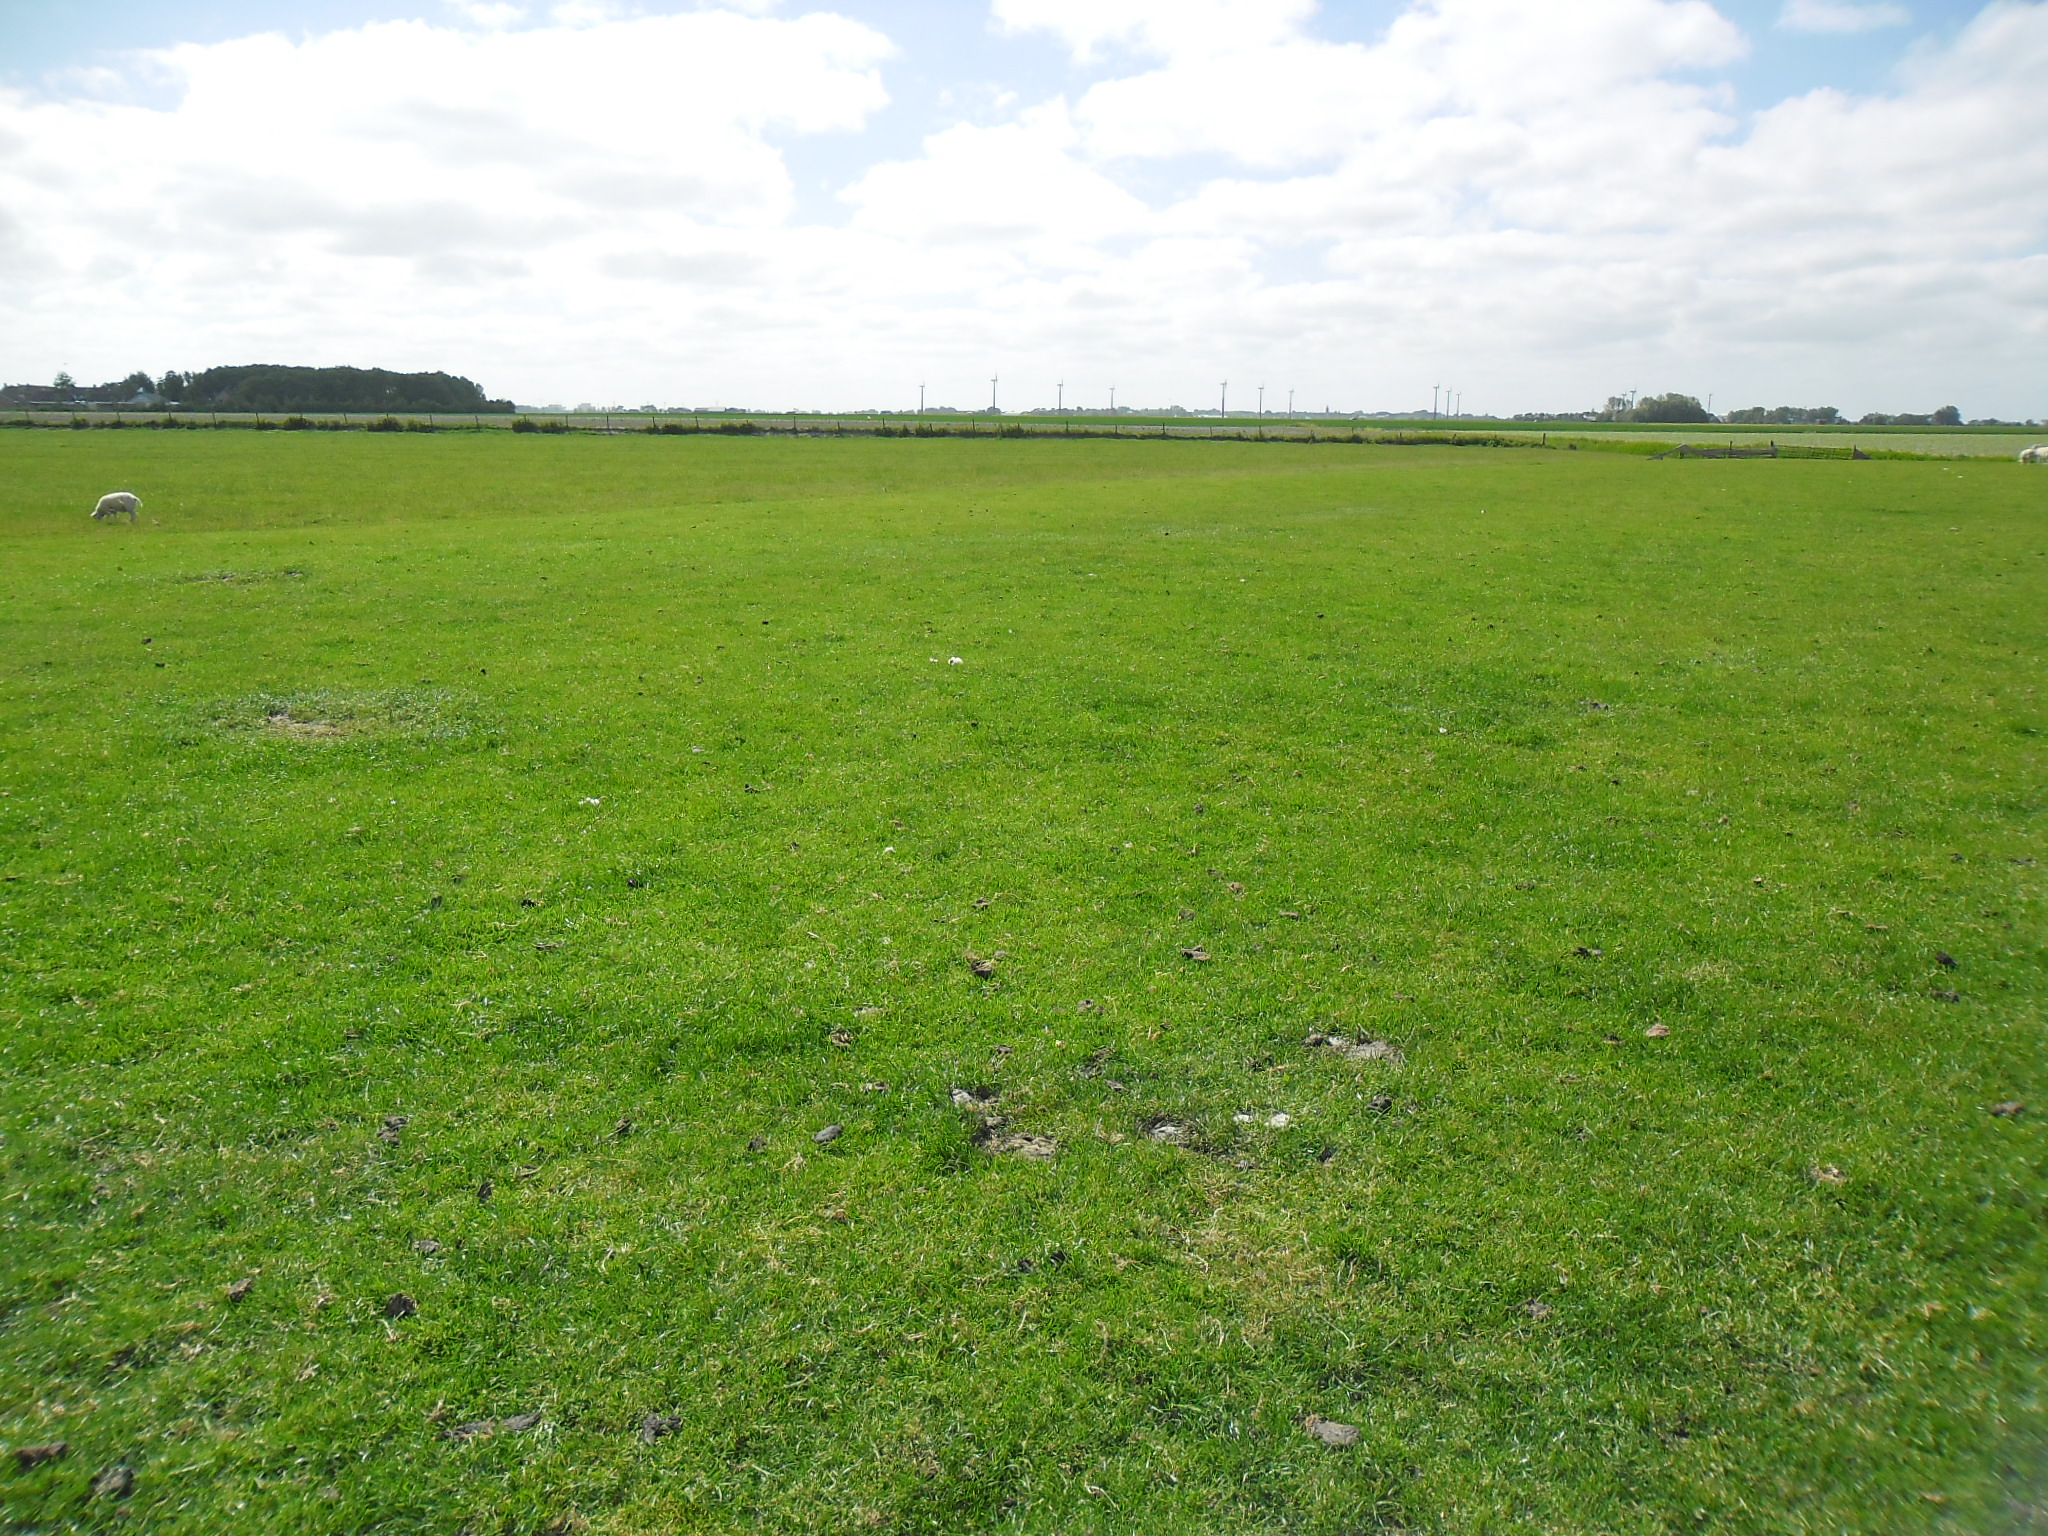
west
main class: Grassland
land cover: Grassland without tree/shrub cover
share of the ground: > 75 %
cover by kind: herbaceous plants 100 %
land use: Agriculture (excluding fallow land and kitchen gardens)
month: June
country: NL
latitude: 53.2123
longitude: 5.5515
